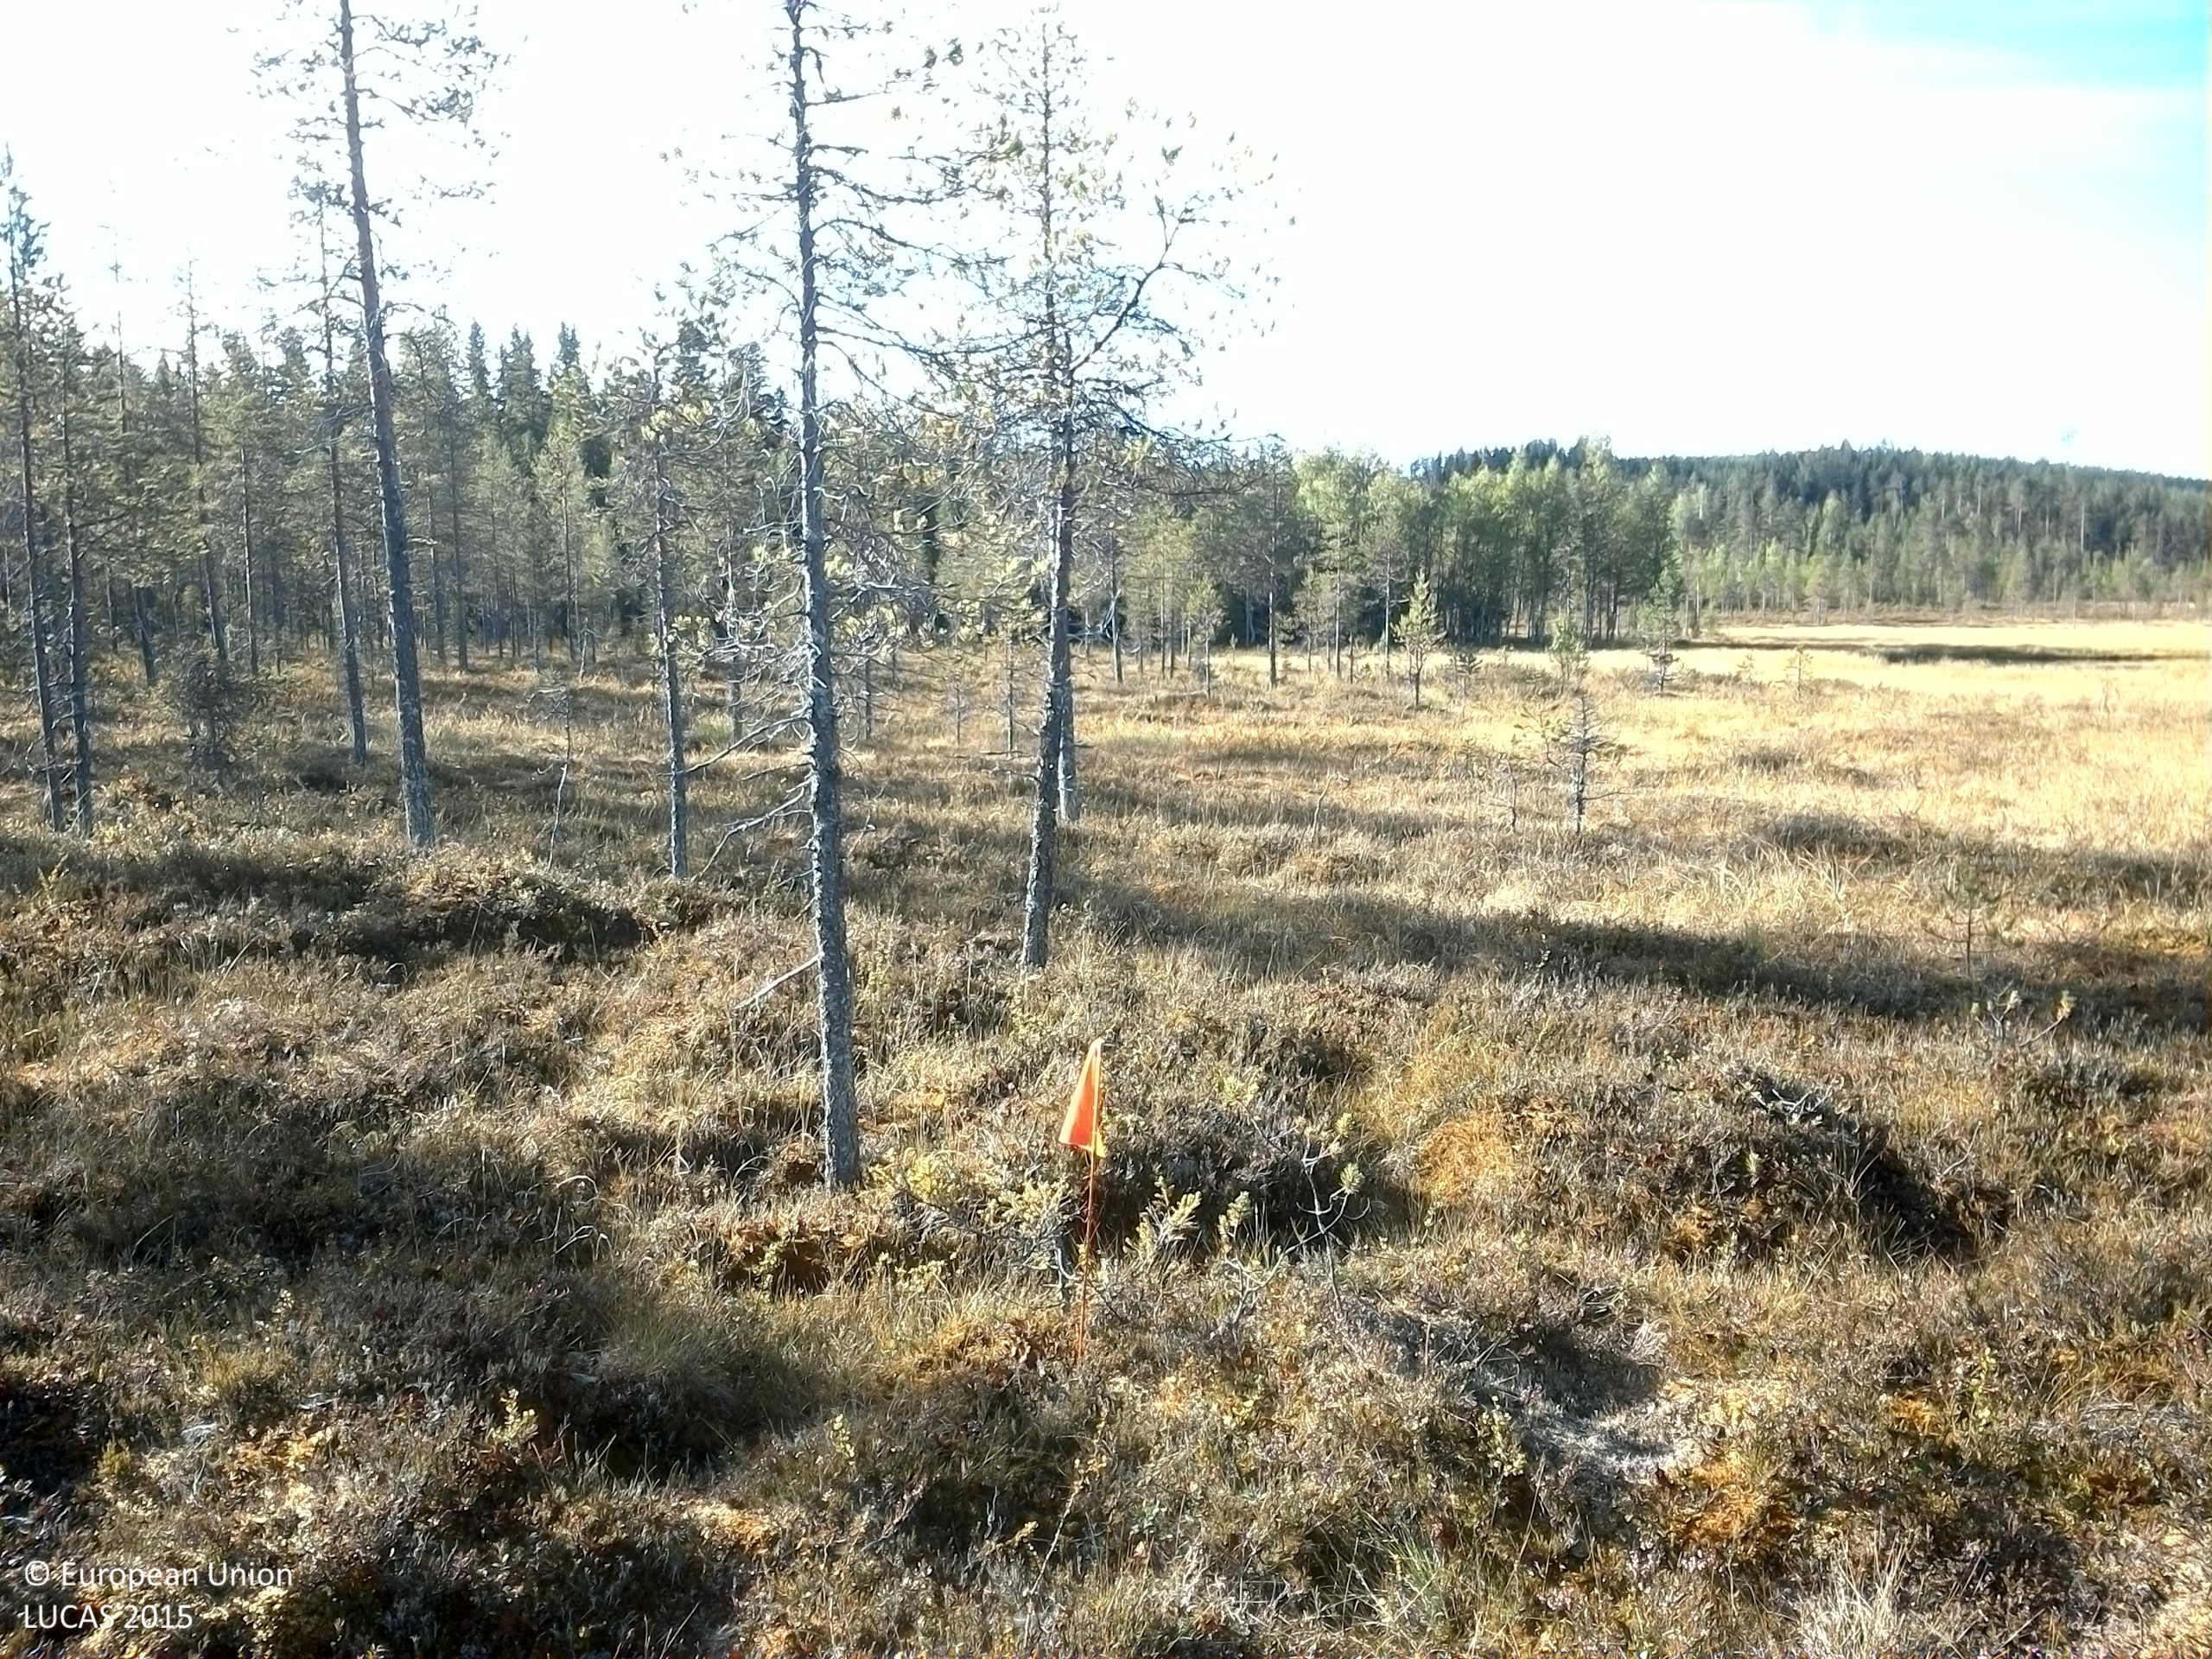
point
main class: Woodland
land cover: Pine dominated coniferous woodland
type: boreal forest
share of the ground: 10 - 25 %
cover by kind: lichens and mosses 50 %, shrubs 35 %, coniferous forest trees 15 %
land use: Semi-natural and natural areas not in use
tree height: < 5 m
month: September
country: SE
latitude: 63.9785
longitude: 17.6322
